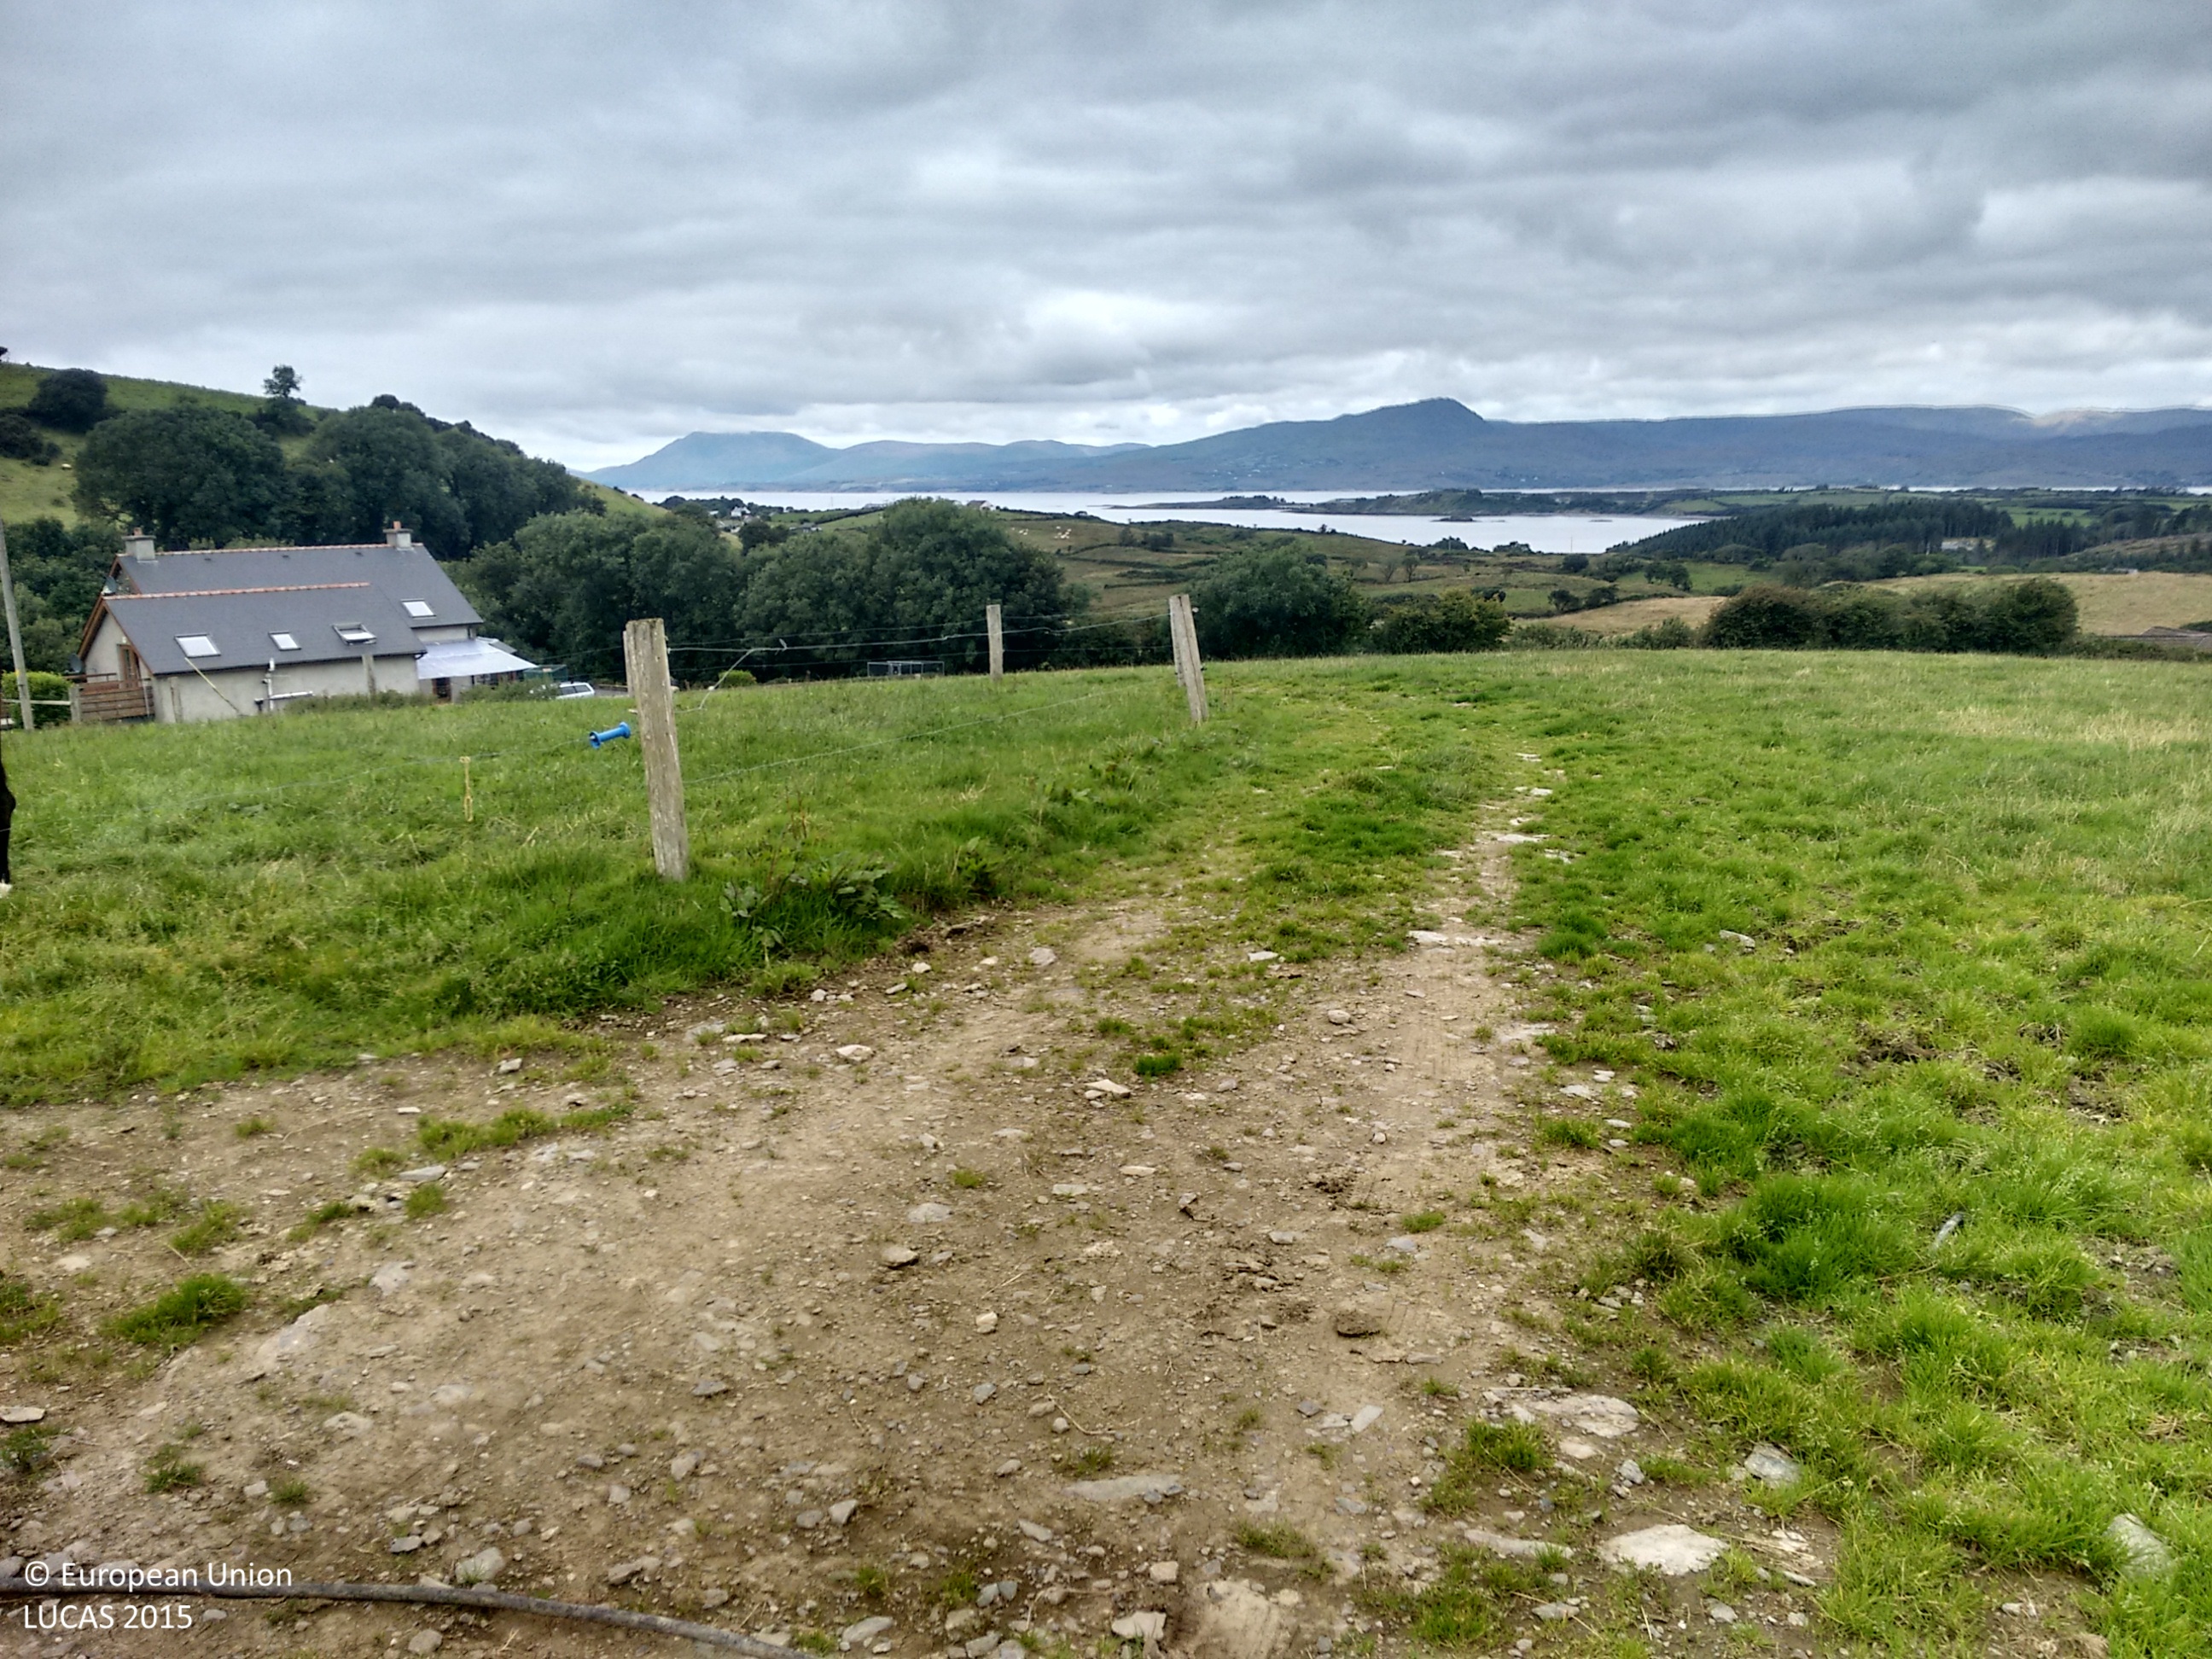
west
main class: Grassland
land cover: Grassland without tree/shrub cover
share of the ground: > 75 %
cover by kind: herbaceous plants 100 %
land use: Agriculture (excluding fallow land and kitchen gardens)
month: August
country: IE
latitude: 51.6669
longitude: -9.4761
